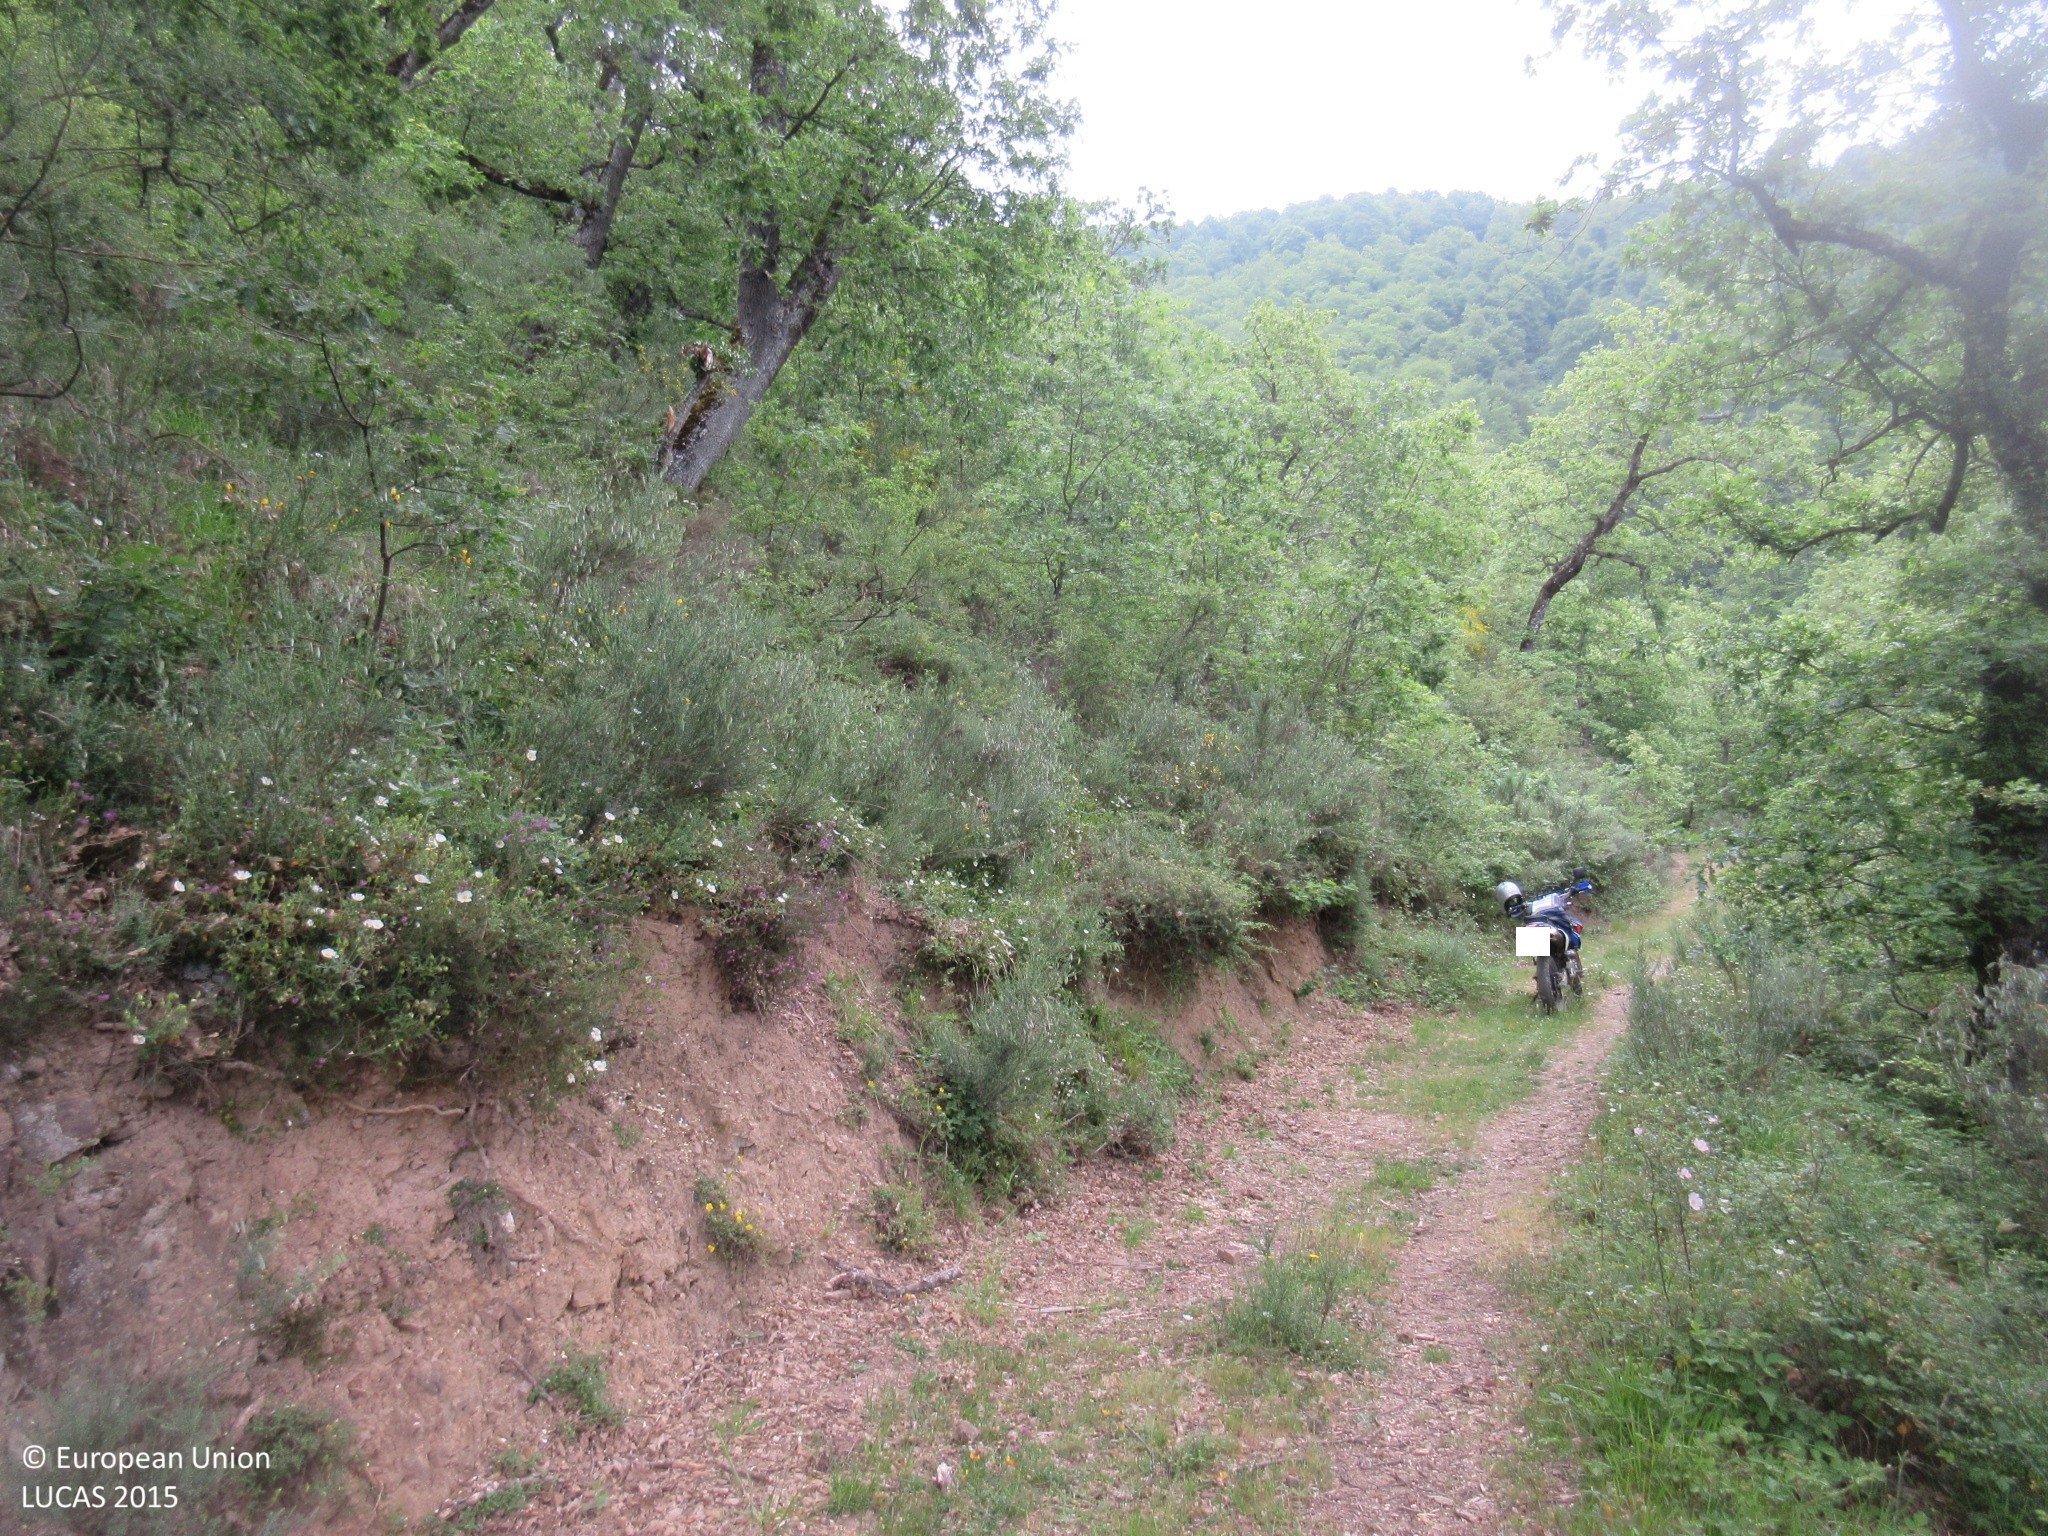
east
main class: Woodland
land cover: Broadleaved woodland
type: thermophilous deciduous forest
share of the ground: > 75 %
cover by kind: broadleaved forest trees 95 %, unconsolidated bare surface 5 %
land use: Semi-natural and natural areas not in use
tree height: > 5 m
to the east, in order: Broadleaved woodland; Tracks; Broadleaved woodland; Tracks; Broadleaved woodland
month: June
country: ES
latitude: 43.1385
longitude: -4.5289
